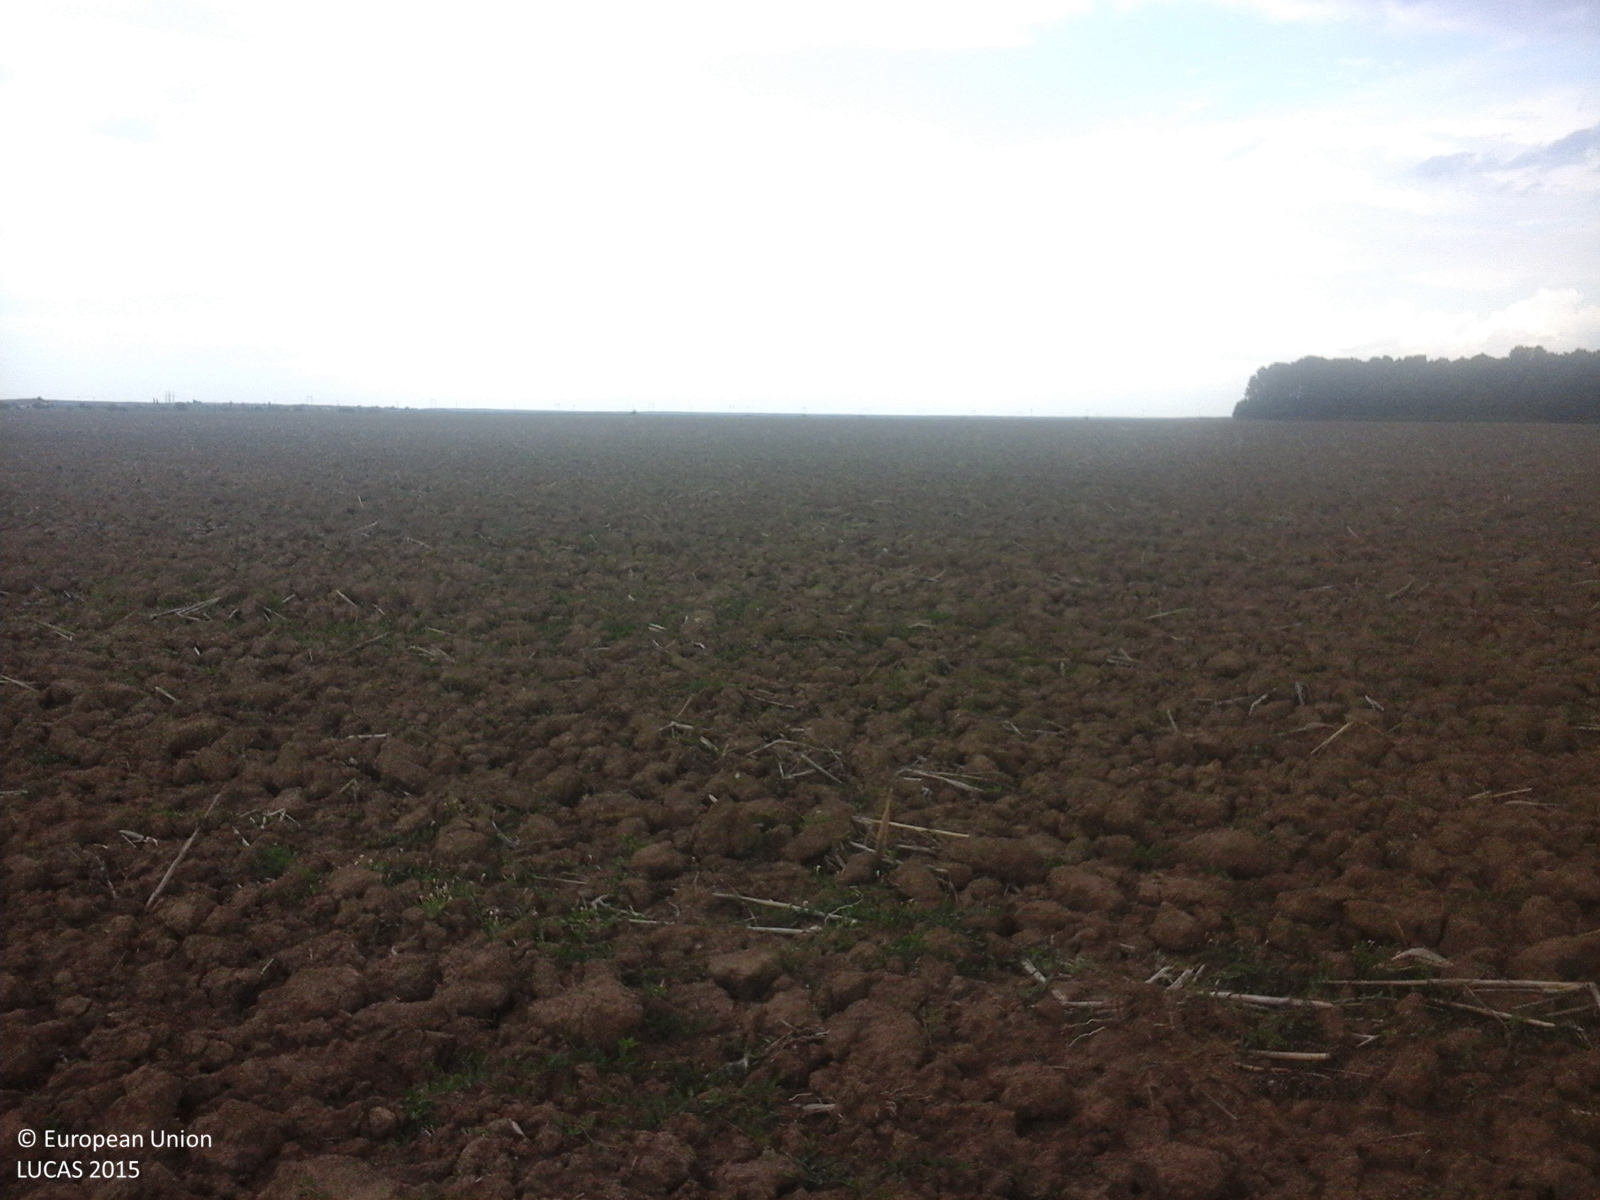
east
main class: Cropland
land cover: Other cereals
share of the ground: < 10 %
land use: Agriculture (excluding fallow land and kitchen gardens)
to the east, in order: Other cereals
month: July
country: RO
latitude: 44.4805
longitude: 25.4931
